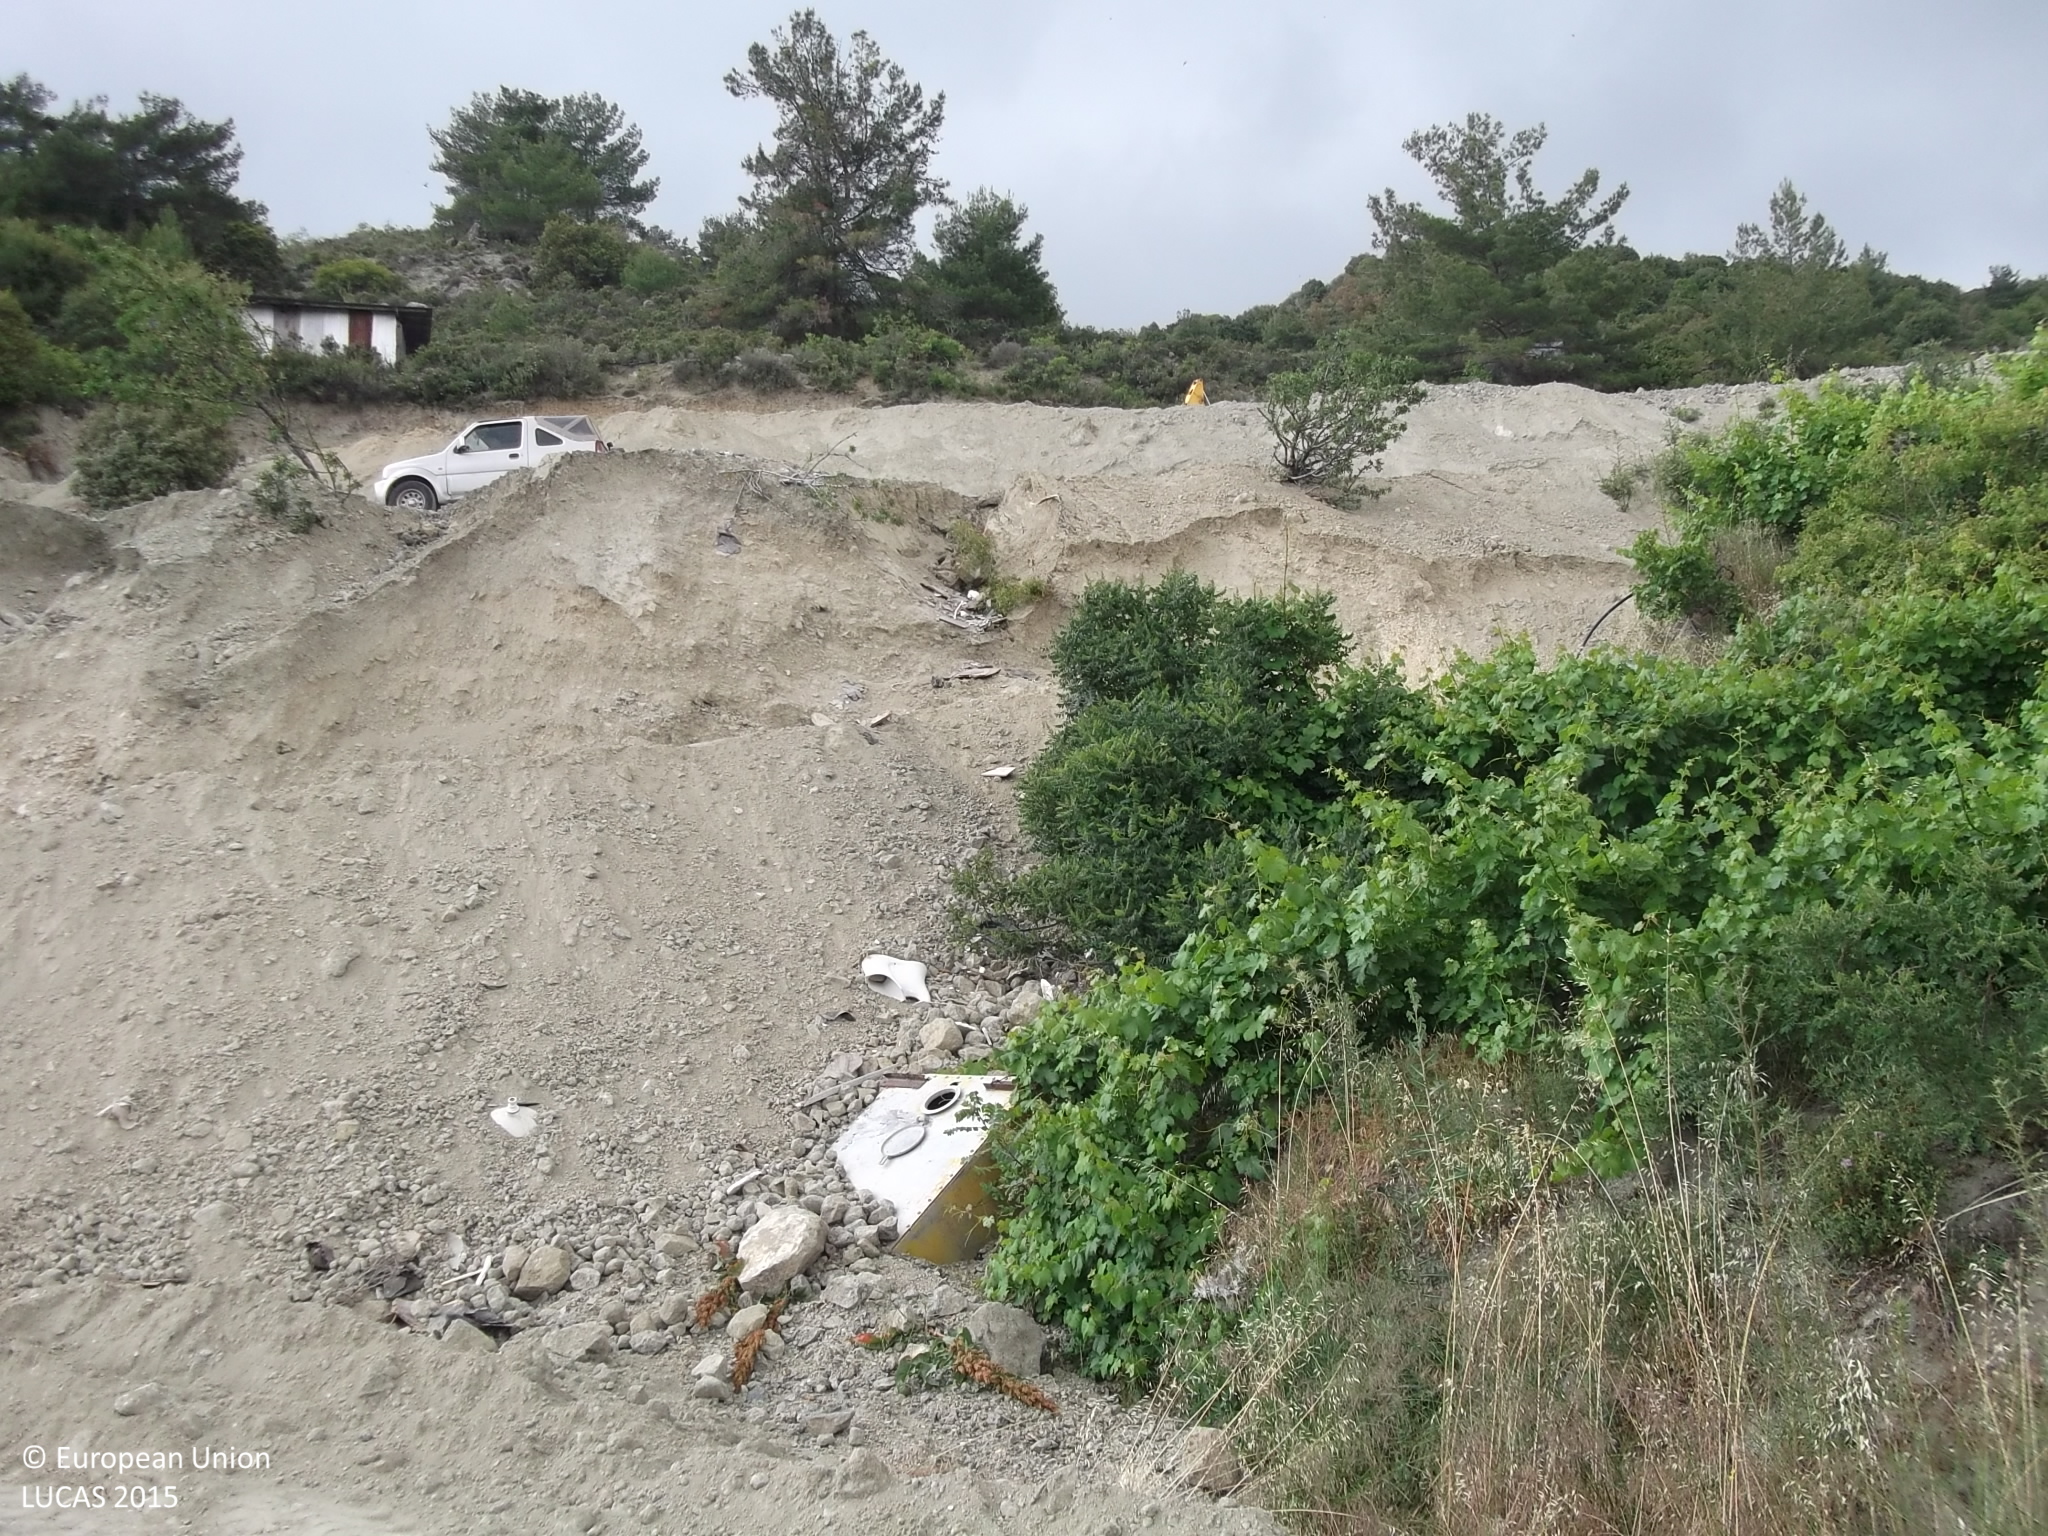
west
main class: Woodland
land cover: Broadleaved woodland
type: broadleaved evergreen forest
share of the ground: 10 - 25 %
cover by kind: shrubs 35 %, broadleaved forest trees 20 %, unconsolidated bare surface 20 %, herbaceous plants 15 %, coniferous forest trees 5 %, consolidated bare surface 5 %
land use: Semi-natural and natural areas not in use
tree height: > 5 m
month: June
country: CY
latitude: 34.9317
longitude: 32.9746
